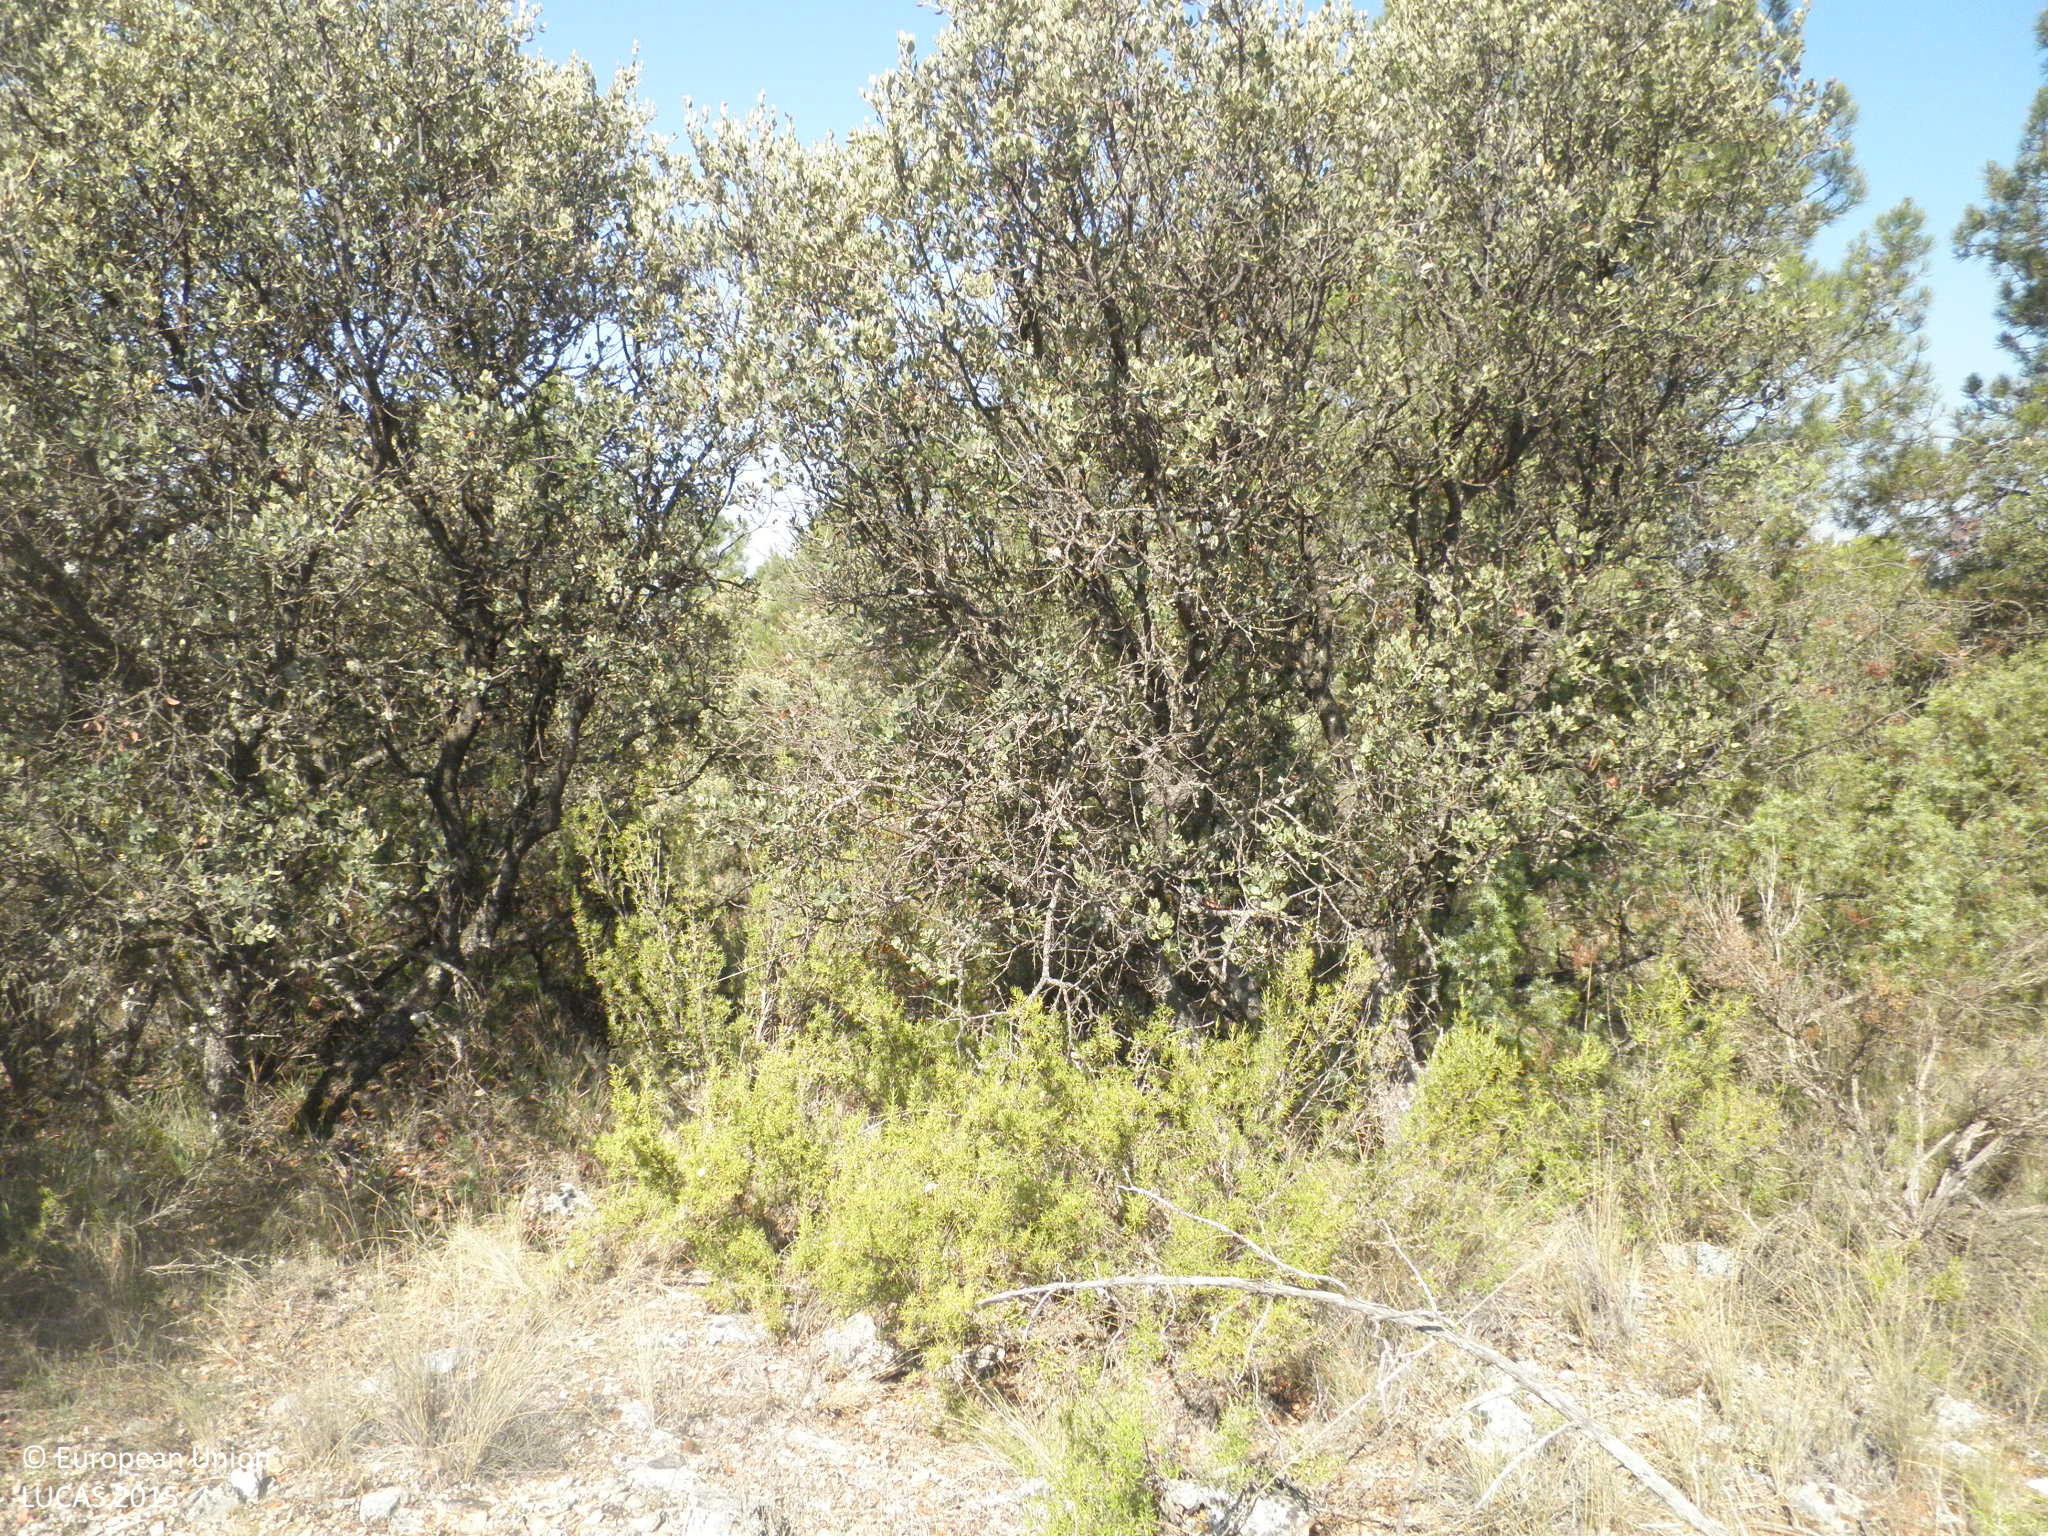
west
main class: Woodland
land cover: Pine dominated mixed woodland
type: coniferous forest of the mediterranean region
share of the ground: 25 - 50 %
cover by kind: coniferous forest trees 25 %, unconsolidated bare surface 25 %, broadleaved forest trees 20 %, shrubs 15 %, herbaceous plants 15 %
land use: Semi-natural and natural areas not in use
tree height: > 5 m
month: July
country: ES
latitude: 39.6302
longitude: -1.7630
